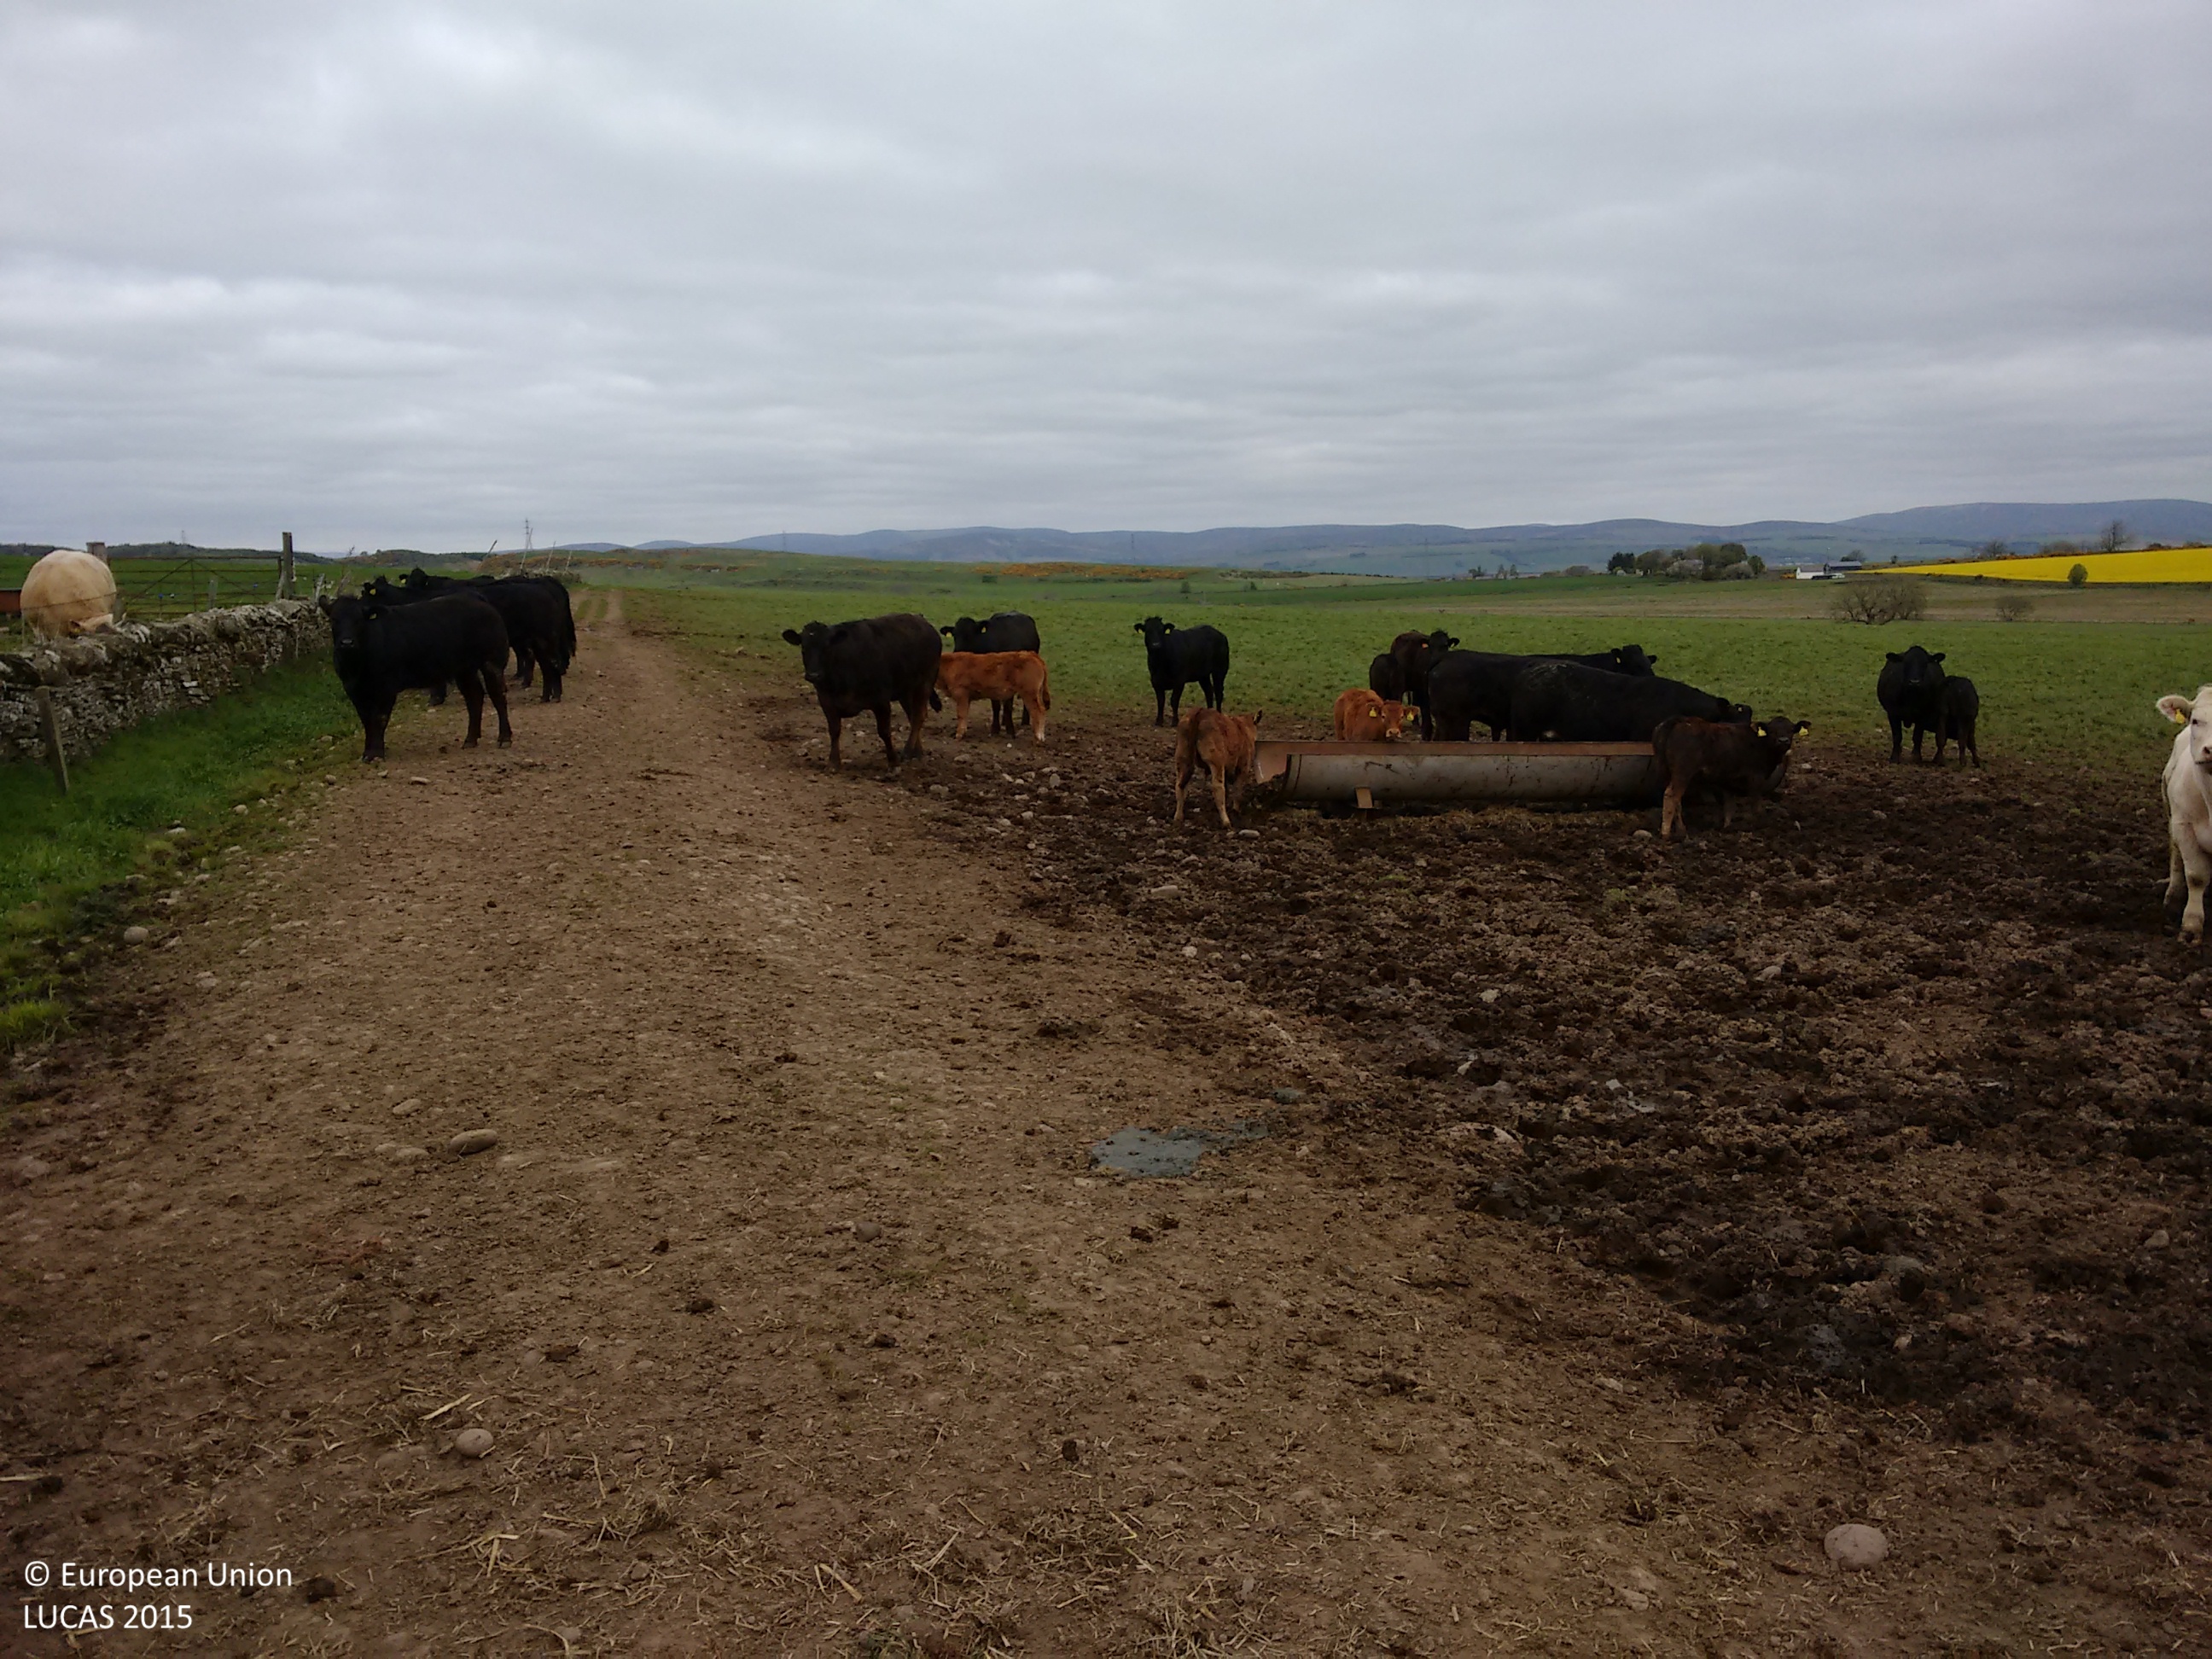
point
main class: Grassland
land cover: Grassland without tree/shrub cover
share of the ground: 50 - 75 %
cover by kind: herbaceous plants 75 %, unconsolidated bare surface 25 %
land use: Agriculture (excluding fallow land and kitchen gardens)
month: May
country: GB
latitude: 56.6763
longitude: -2.7753
